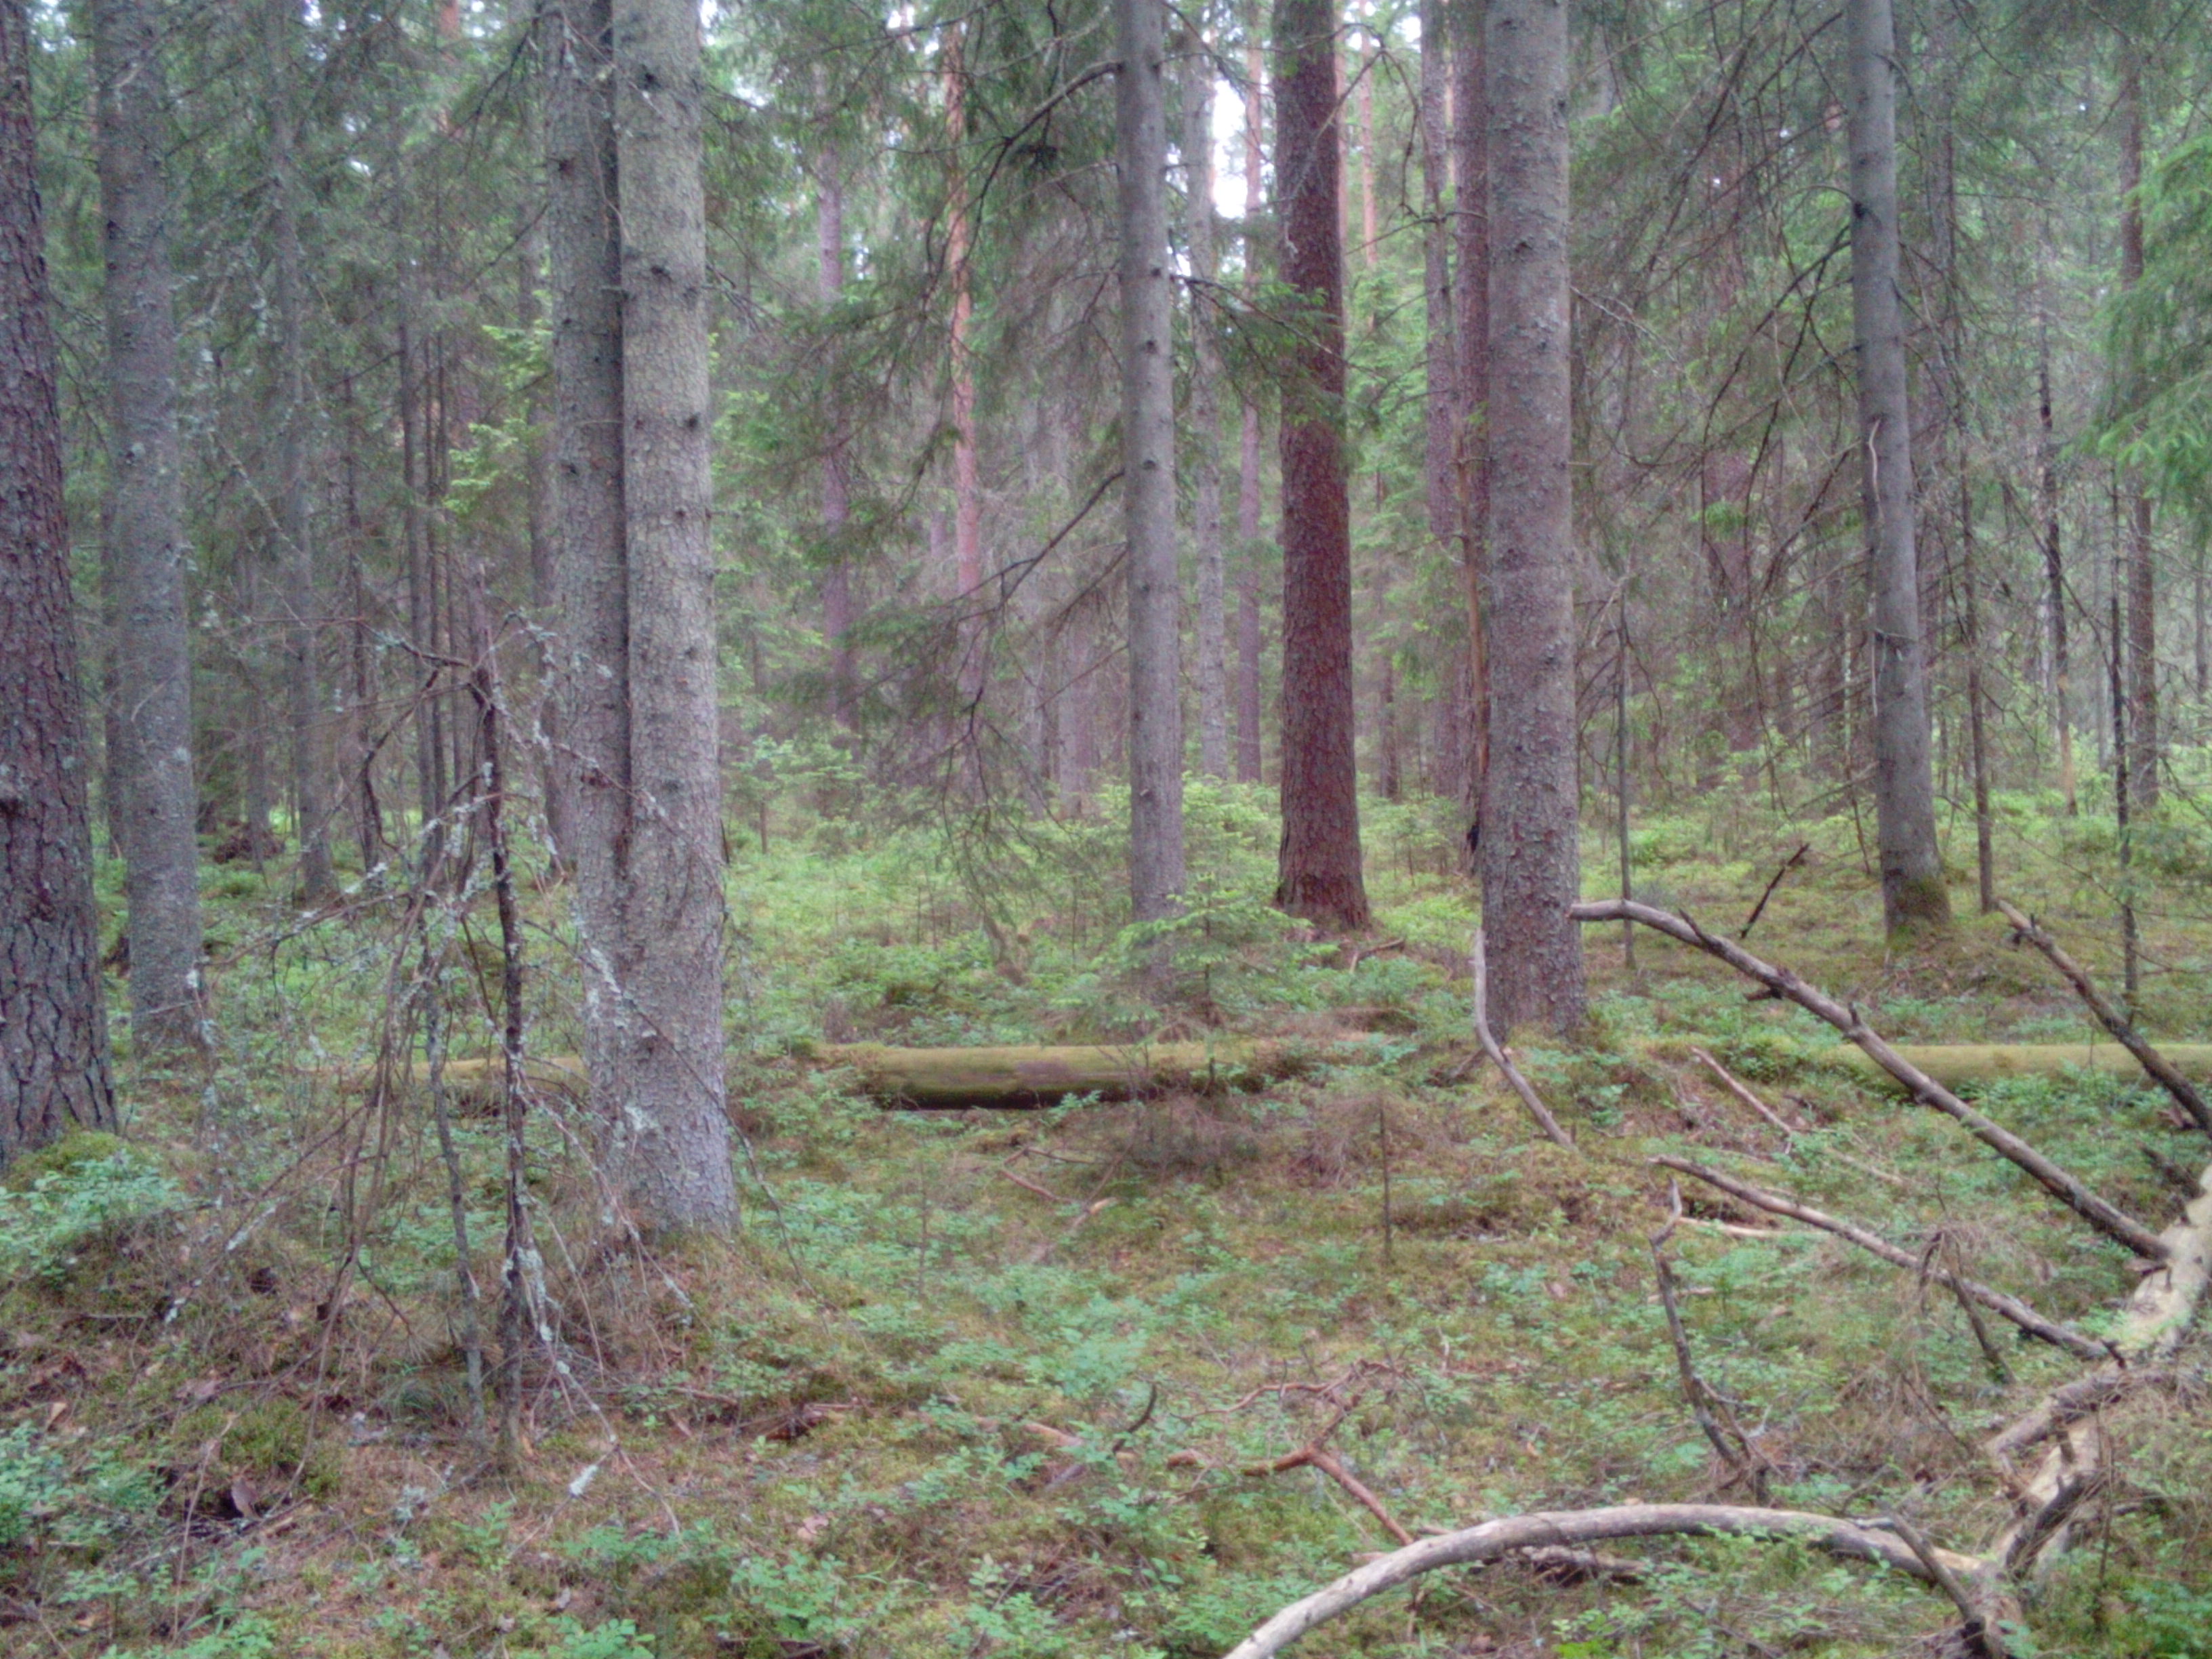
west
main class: Woodland
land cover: Other coniferous woodland
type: hemiboreal forest and nemoral coniferous forest and mixed broadleaved-coniferous forest
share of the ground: > 75 %
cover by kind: coniferous forest trees 85 %, herbaceous plants 10 %, lichens and mosses 5 %
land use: Forestry
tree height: > 5 m
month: June
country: LV
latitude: 56.8032
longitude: 21.4215
